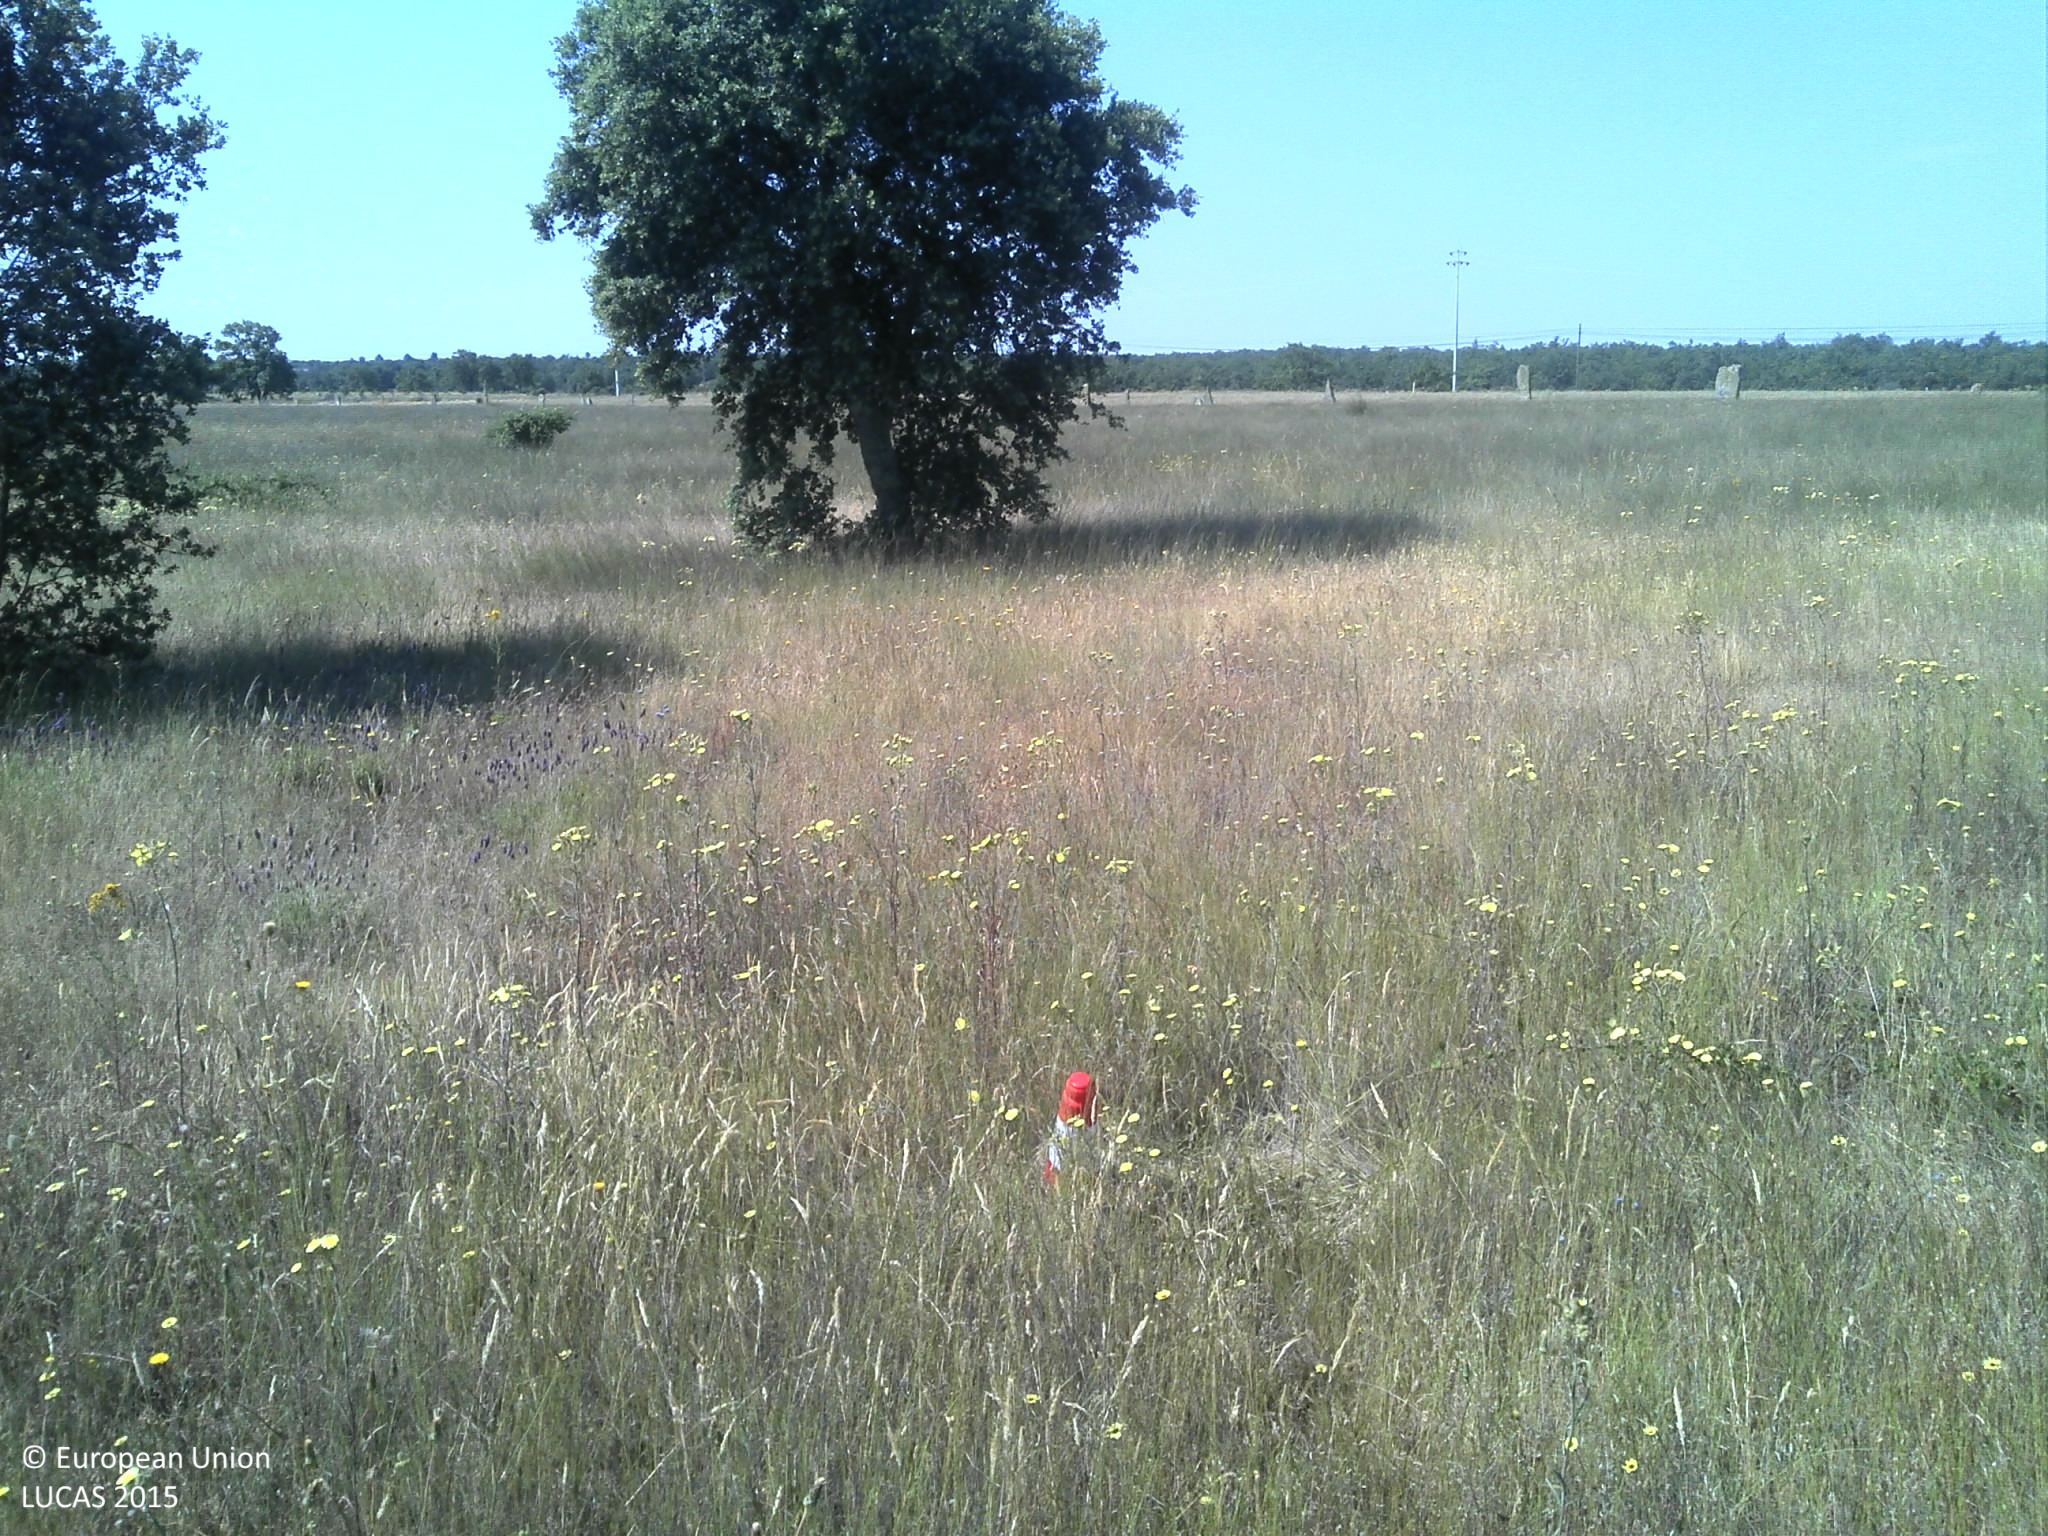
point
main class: Grassland
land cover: Grassland with sparse tree/shrub cover
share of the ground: 50 - 75 %
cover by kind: herbaceous plants 60 %, unconsolidated bare surface 30 %, broadleaved forest trees 5 %
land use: Agriculture (excluding fallow land and kitchen gardens)
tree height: > 5 m
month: June
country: PT
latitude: 40.5310
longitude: -6.8474
